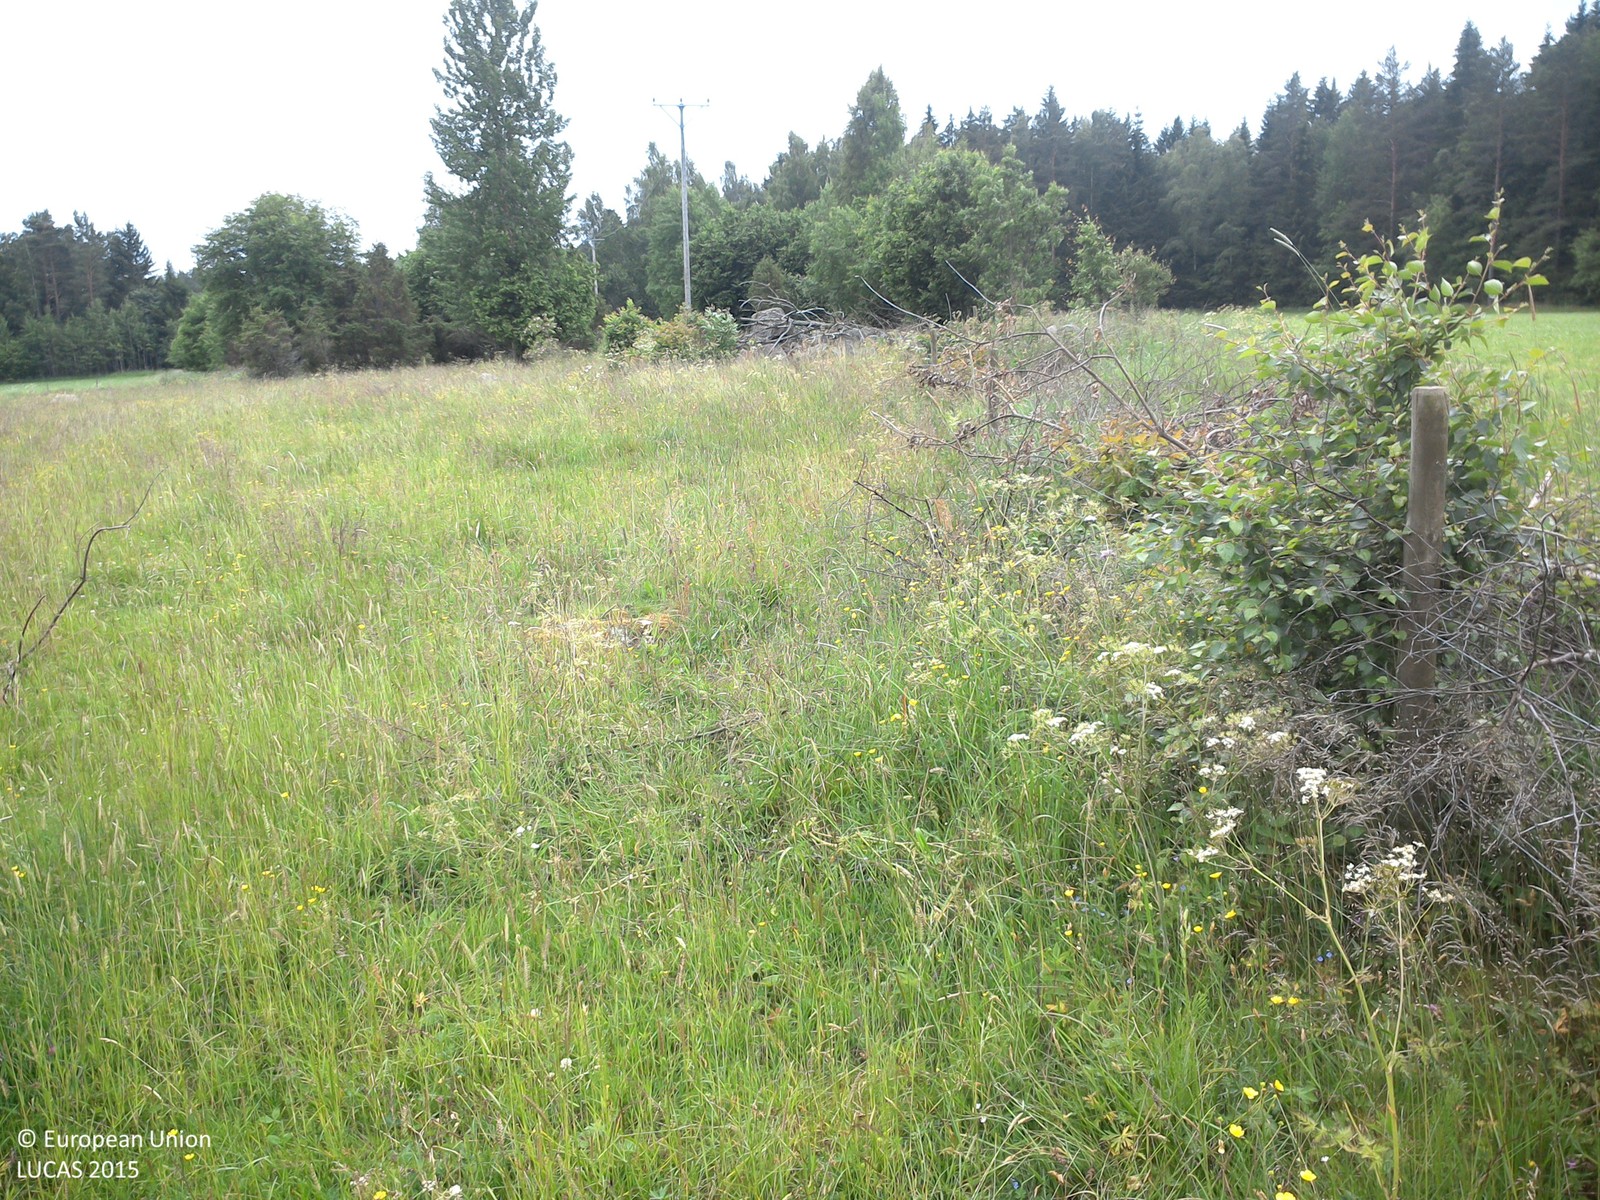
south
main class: Grassland
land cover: Grassland without tree/shrub cover
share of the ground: > 75 %
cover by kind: herbaceous plants 100 %
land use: Agriculture (excluding fallow land and kitchen gardens)
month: June
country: SE
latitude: 58.3065
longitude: 15.4726
